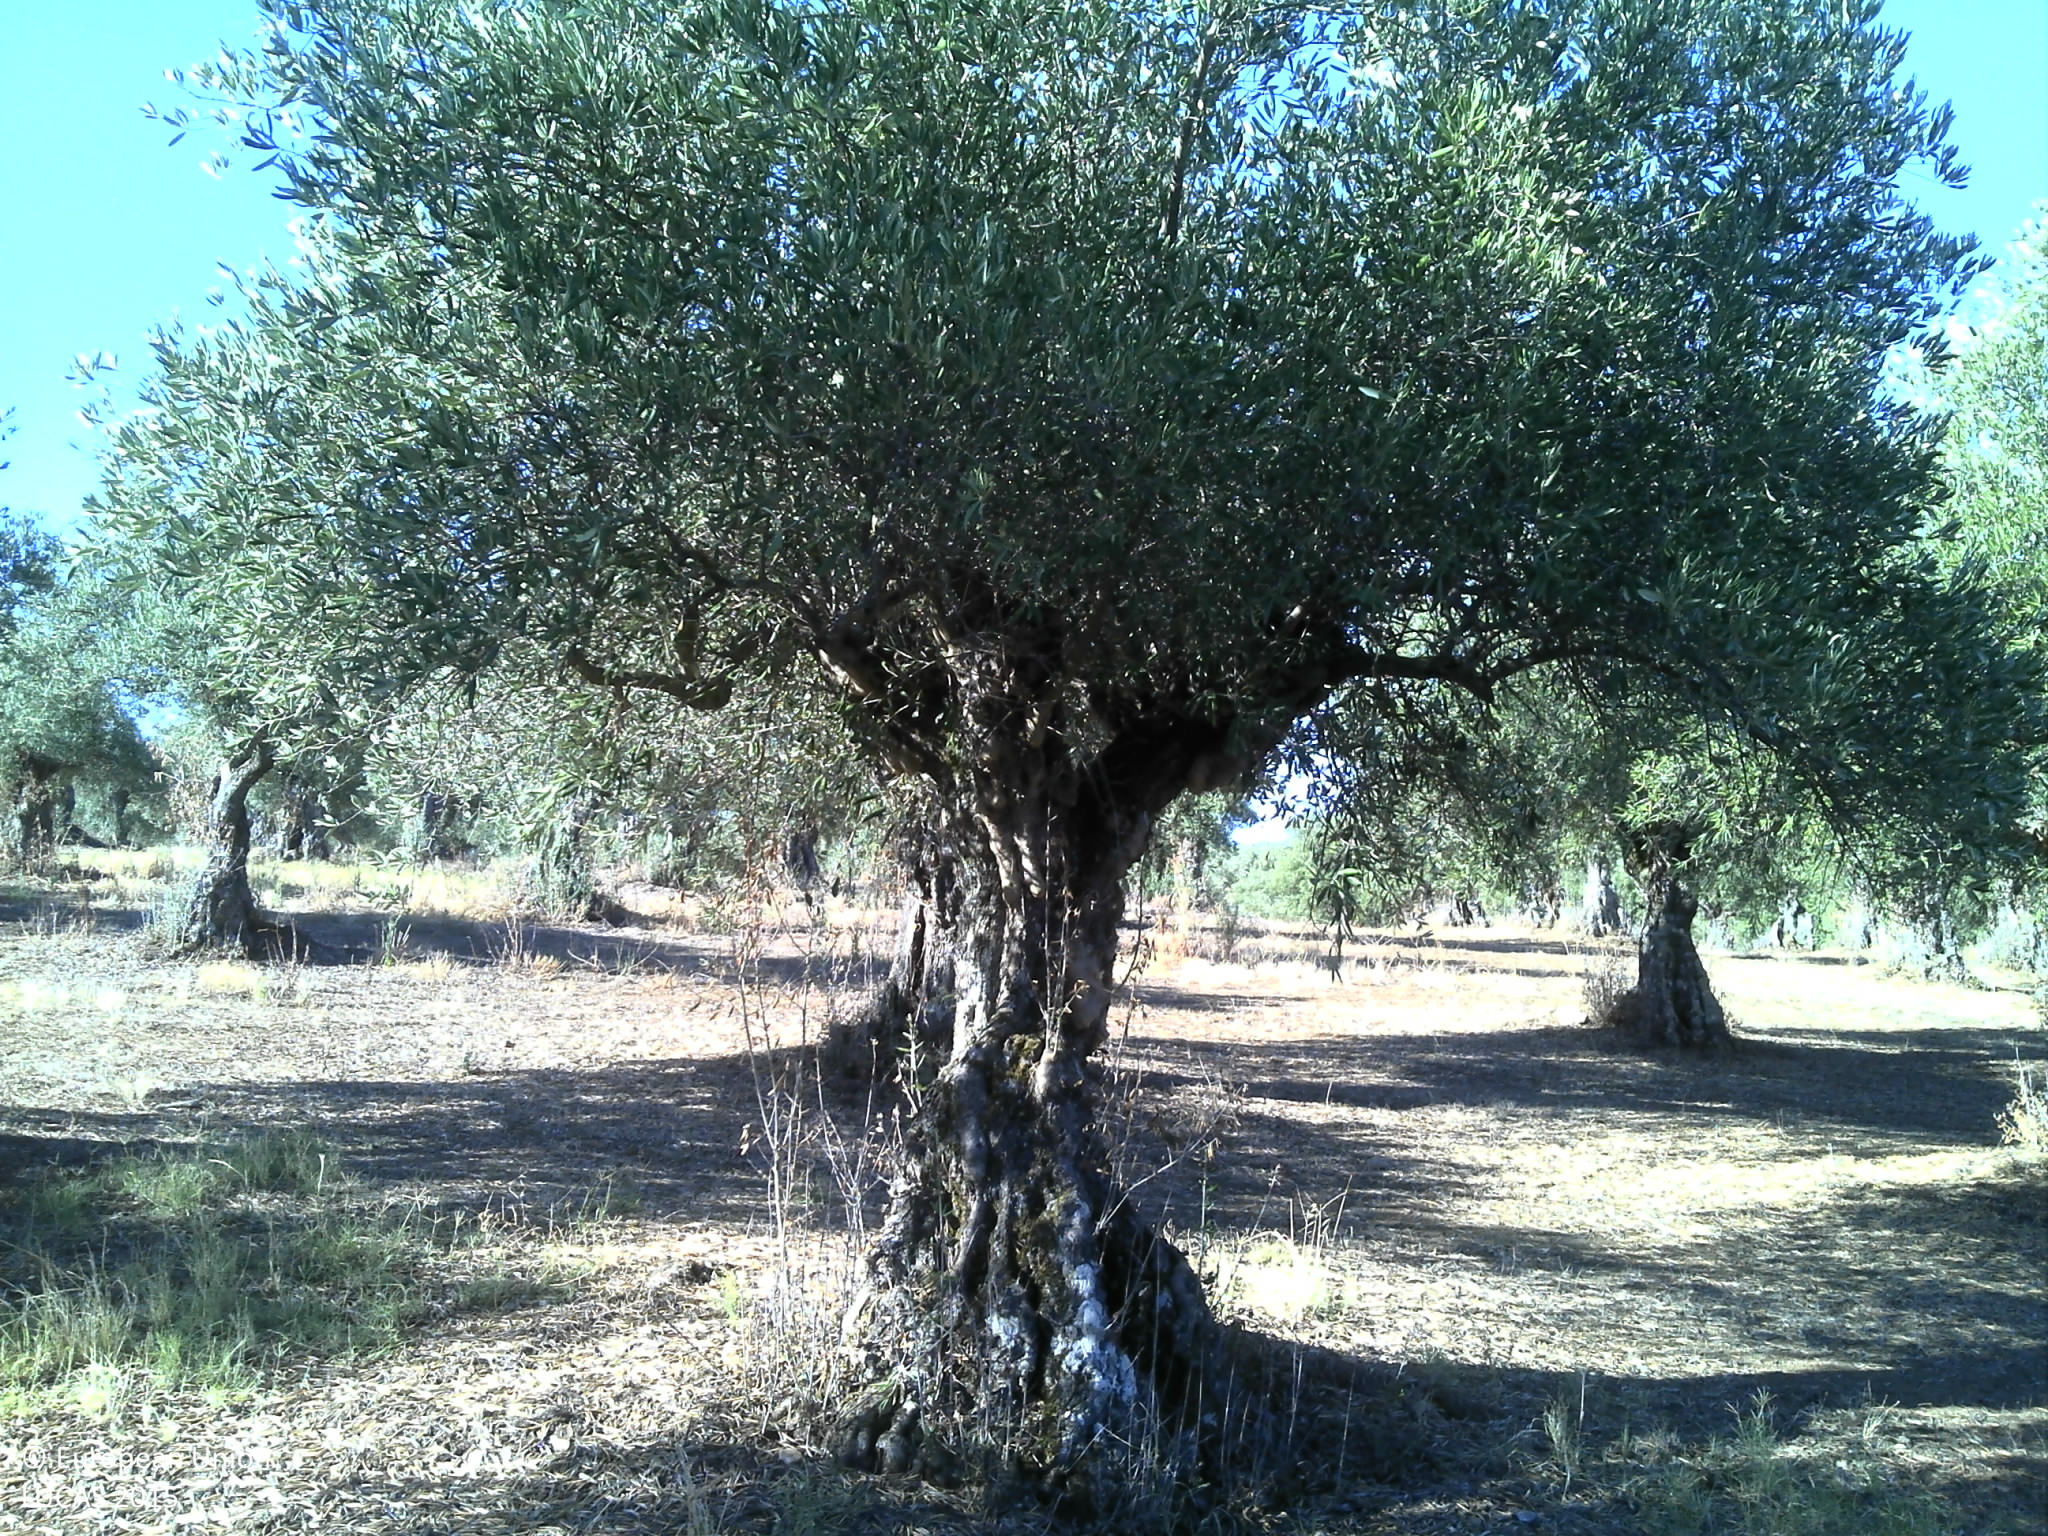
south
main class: Cropland
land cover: Olive groves
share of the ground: 25 - 50 %
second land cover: Grassland without tree/shrub cover
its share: < 10 %
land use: Agriculture (excluding fallow land and kitchen gardens)
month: July
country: PT
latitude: 39.0262
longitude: -7.0188
